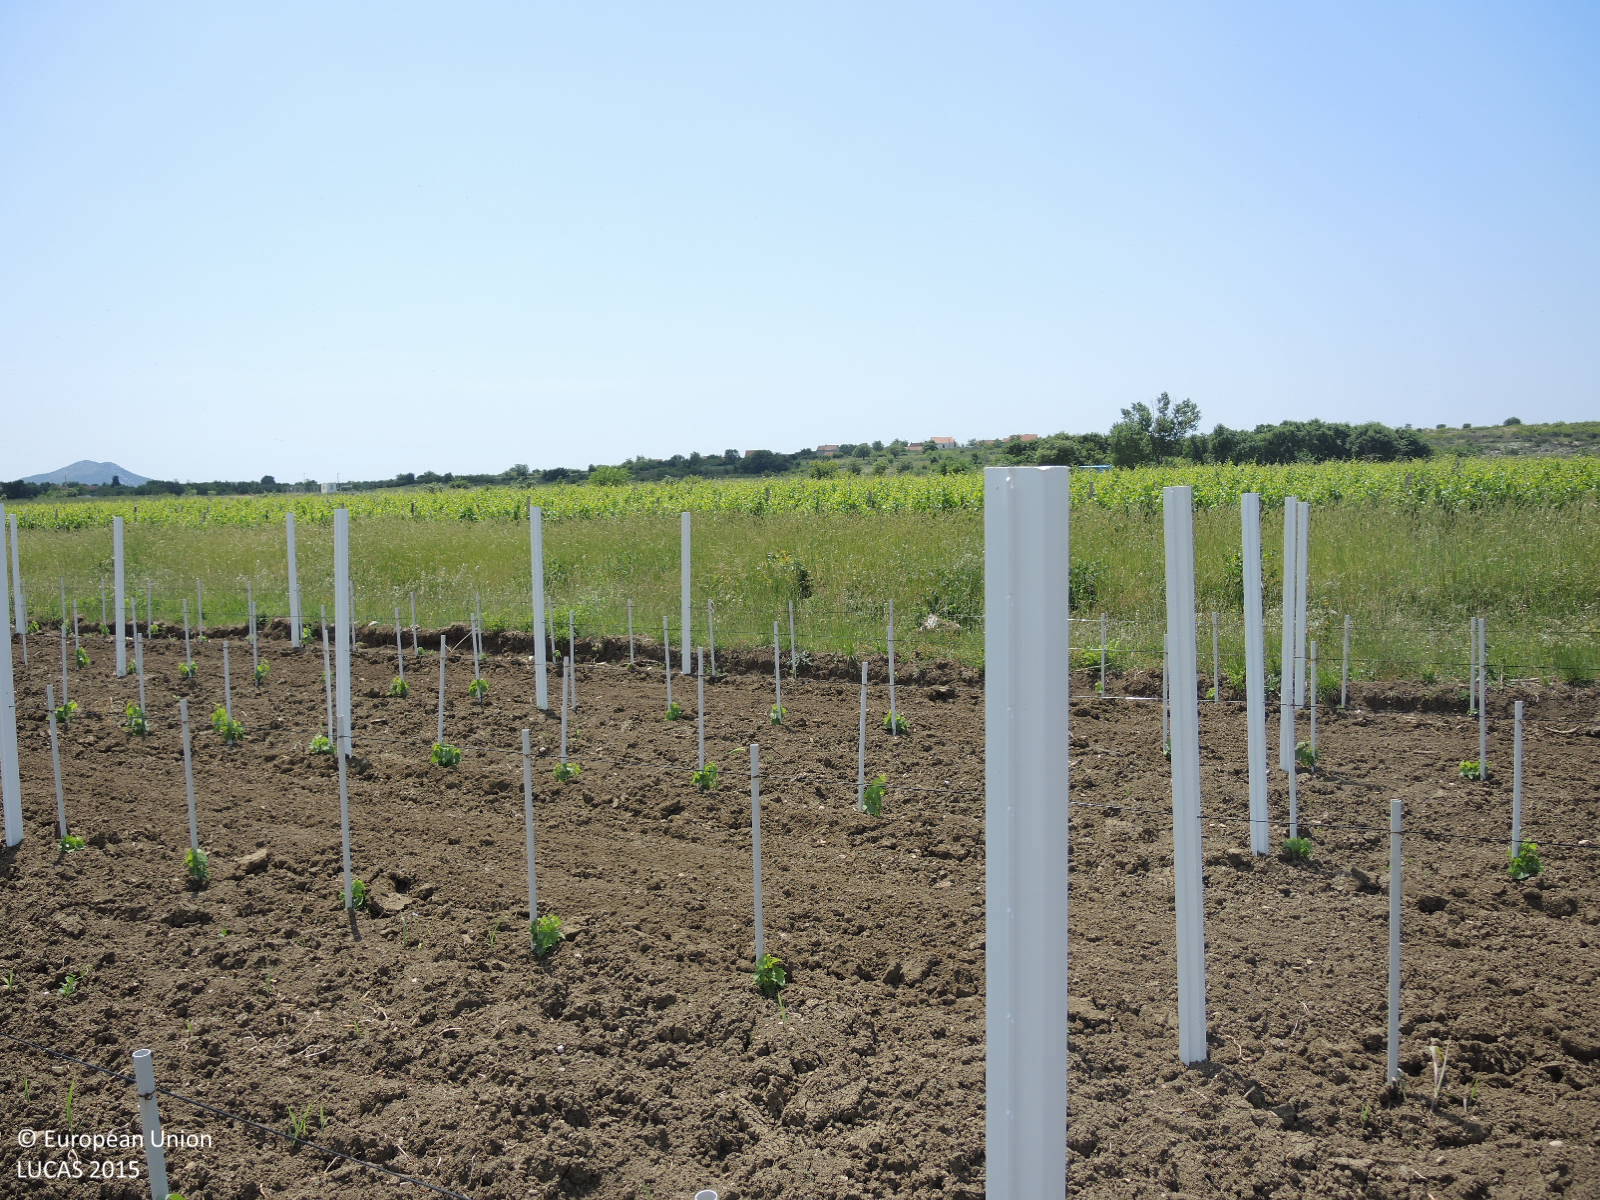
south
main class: Cropland
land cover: Vineyards
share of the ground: < 10 %
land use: Agriculture (excluding fallow land and kitchen gardens)
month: May
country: HR
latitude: 44.0423
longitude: 15.4954
